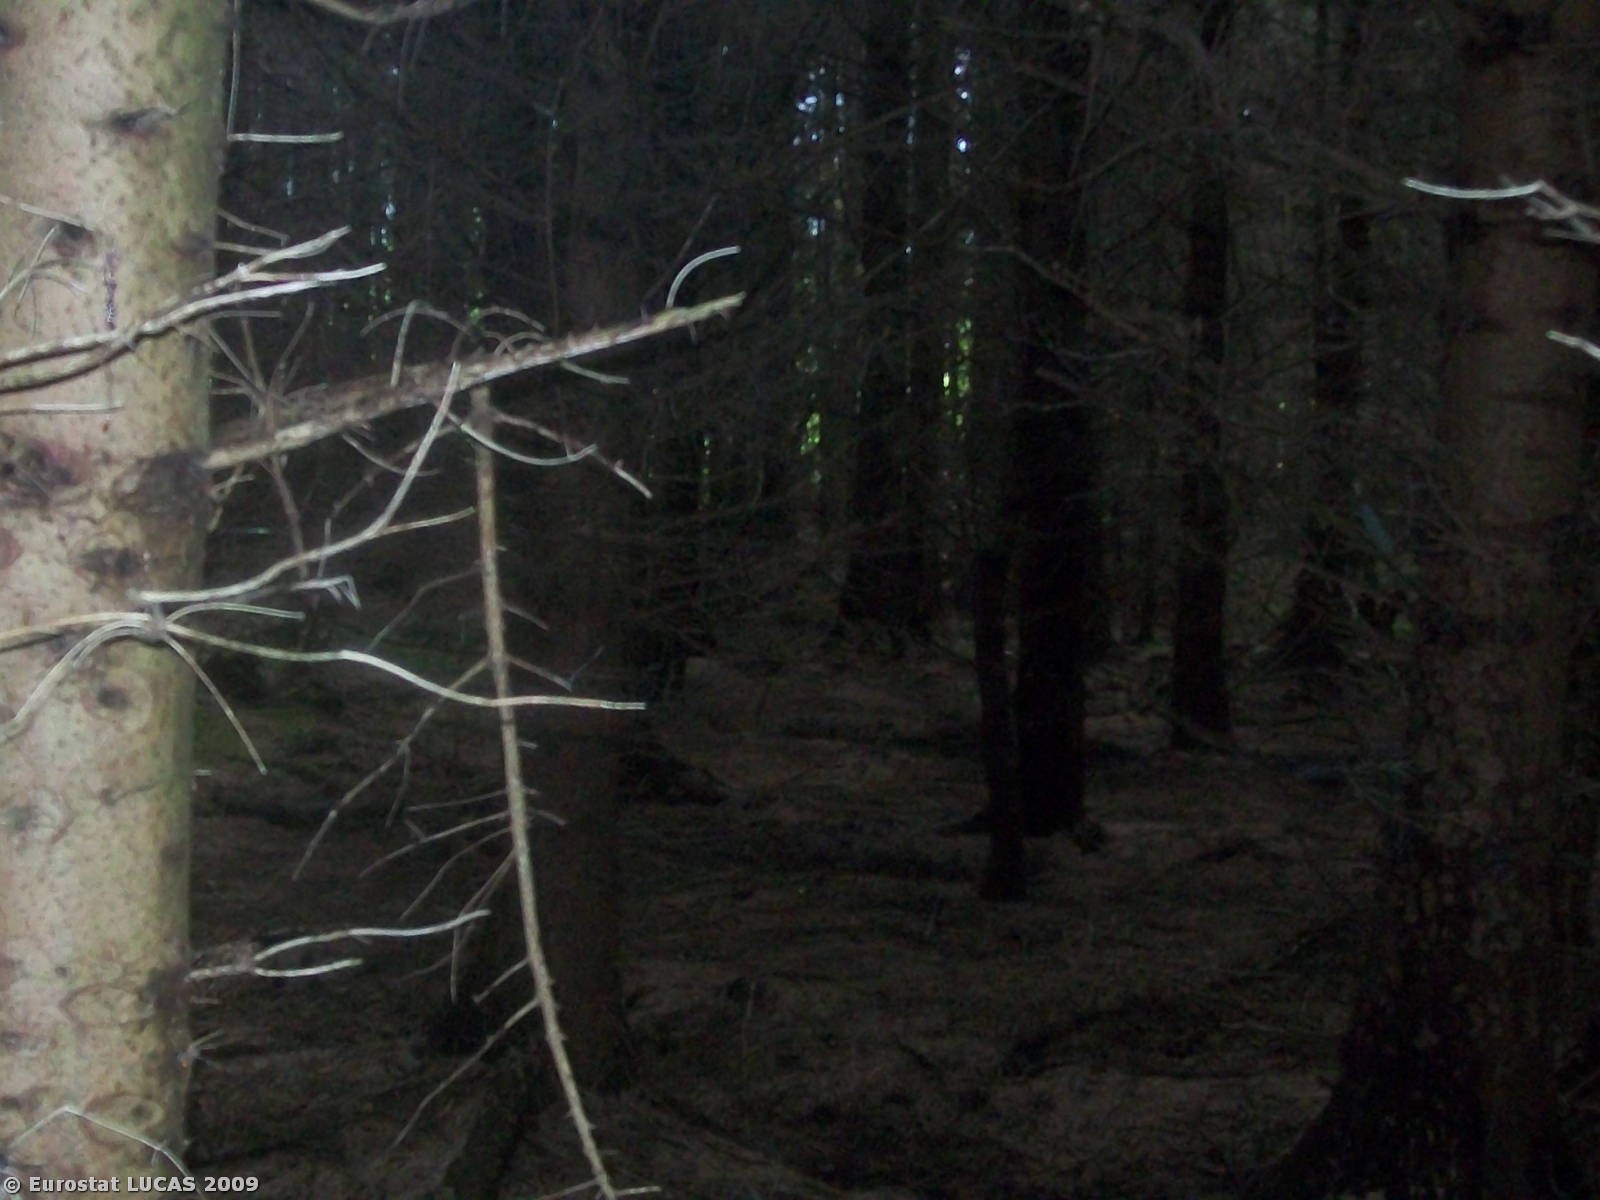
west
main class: Woodland
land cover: Coniferous woodland
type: plantations and self-sown exotic forest
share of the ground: > 75 %
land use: Forestry
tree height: > 5 m
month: July
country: IE
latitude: 54.3753
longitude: -8.5274
